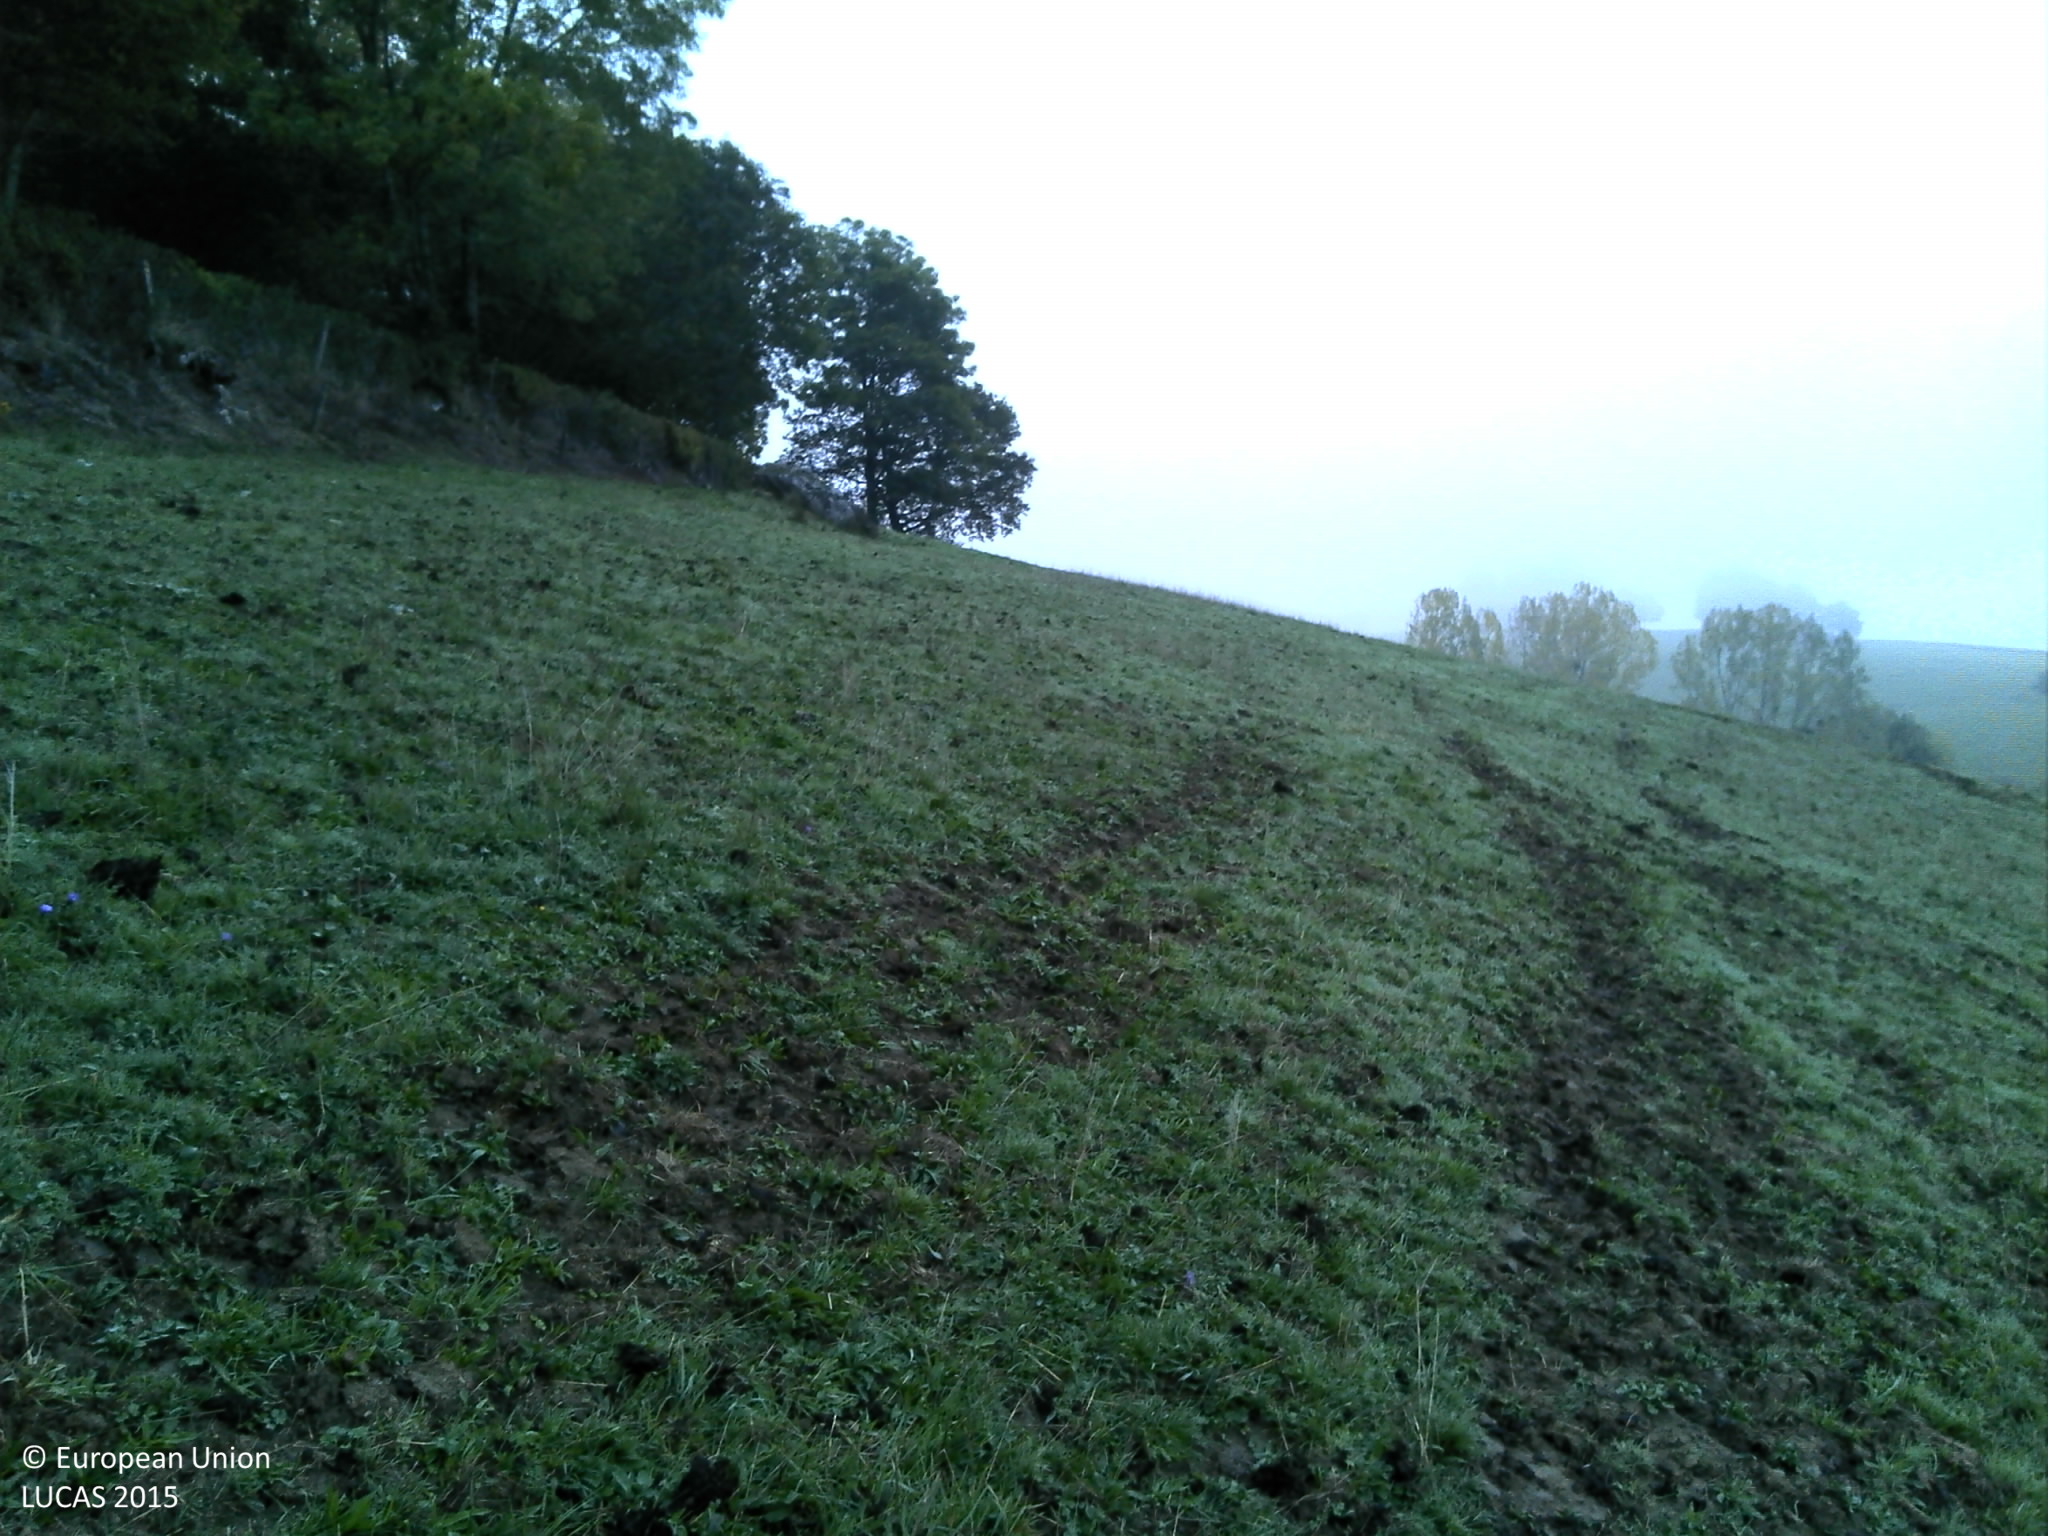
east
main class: Grassland
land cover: Grassland without tree/shrub cover
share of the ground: > 75 %
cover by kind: herbaceous plants 100 %
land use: Agriculture (excluding fallow land and kitchen gardens)
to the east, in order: Grassland without tree/shrub cover; Fences; Abandoned hedges; Tracks; Broadleaved woodland; Tracks; Managed hedges; Fences; Grassland without tree/shrub cover; Grassland with sparse tree/shrub cover; Grassland without tree/shrub cover
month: October
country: FR
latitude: 46.7809
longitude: 4.0401
